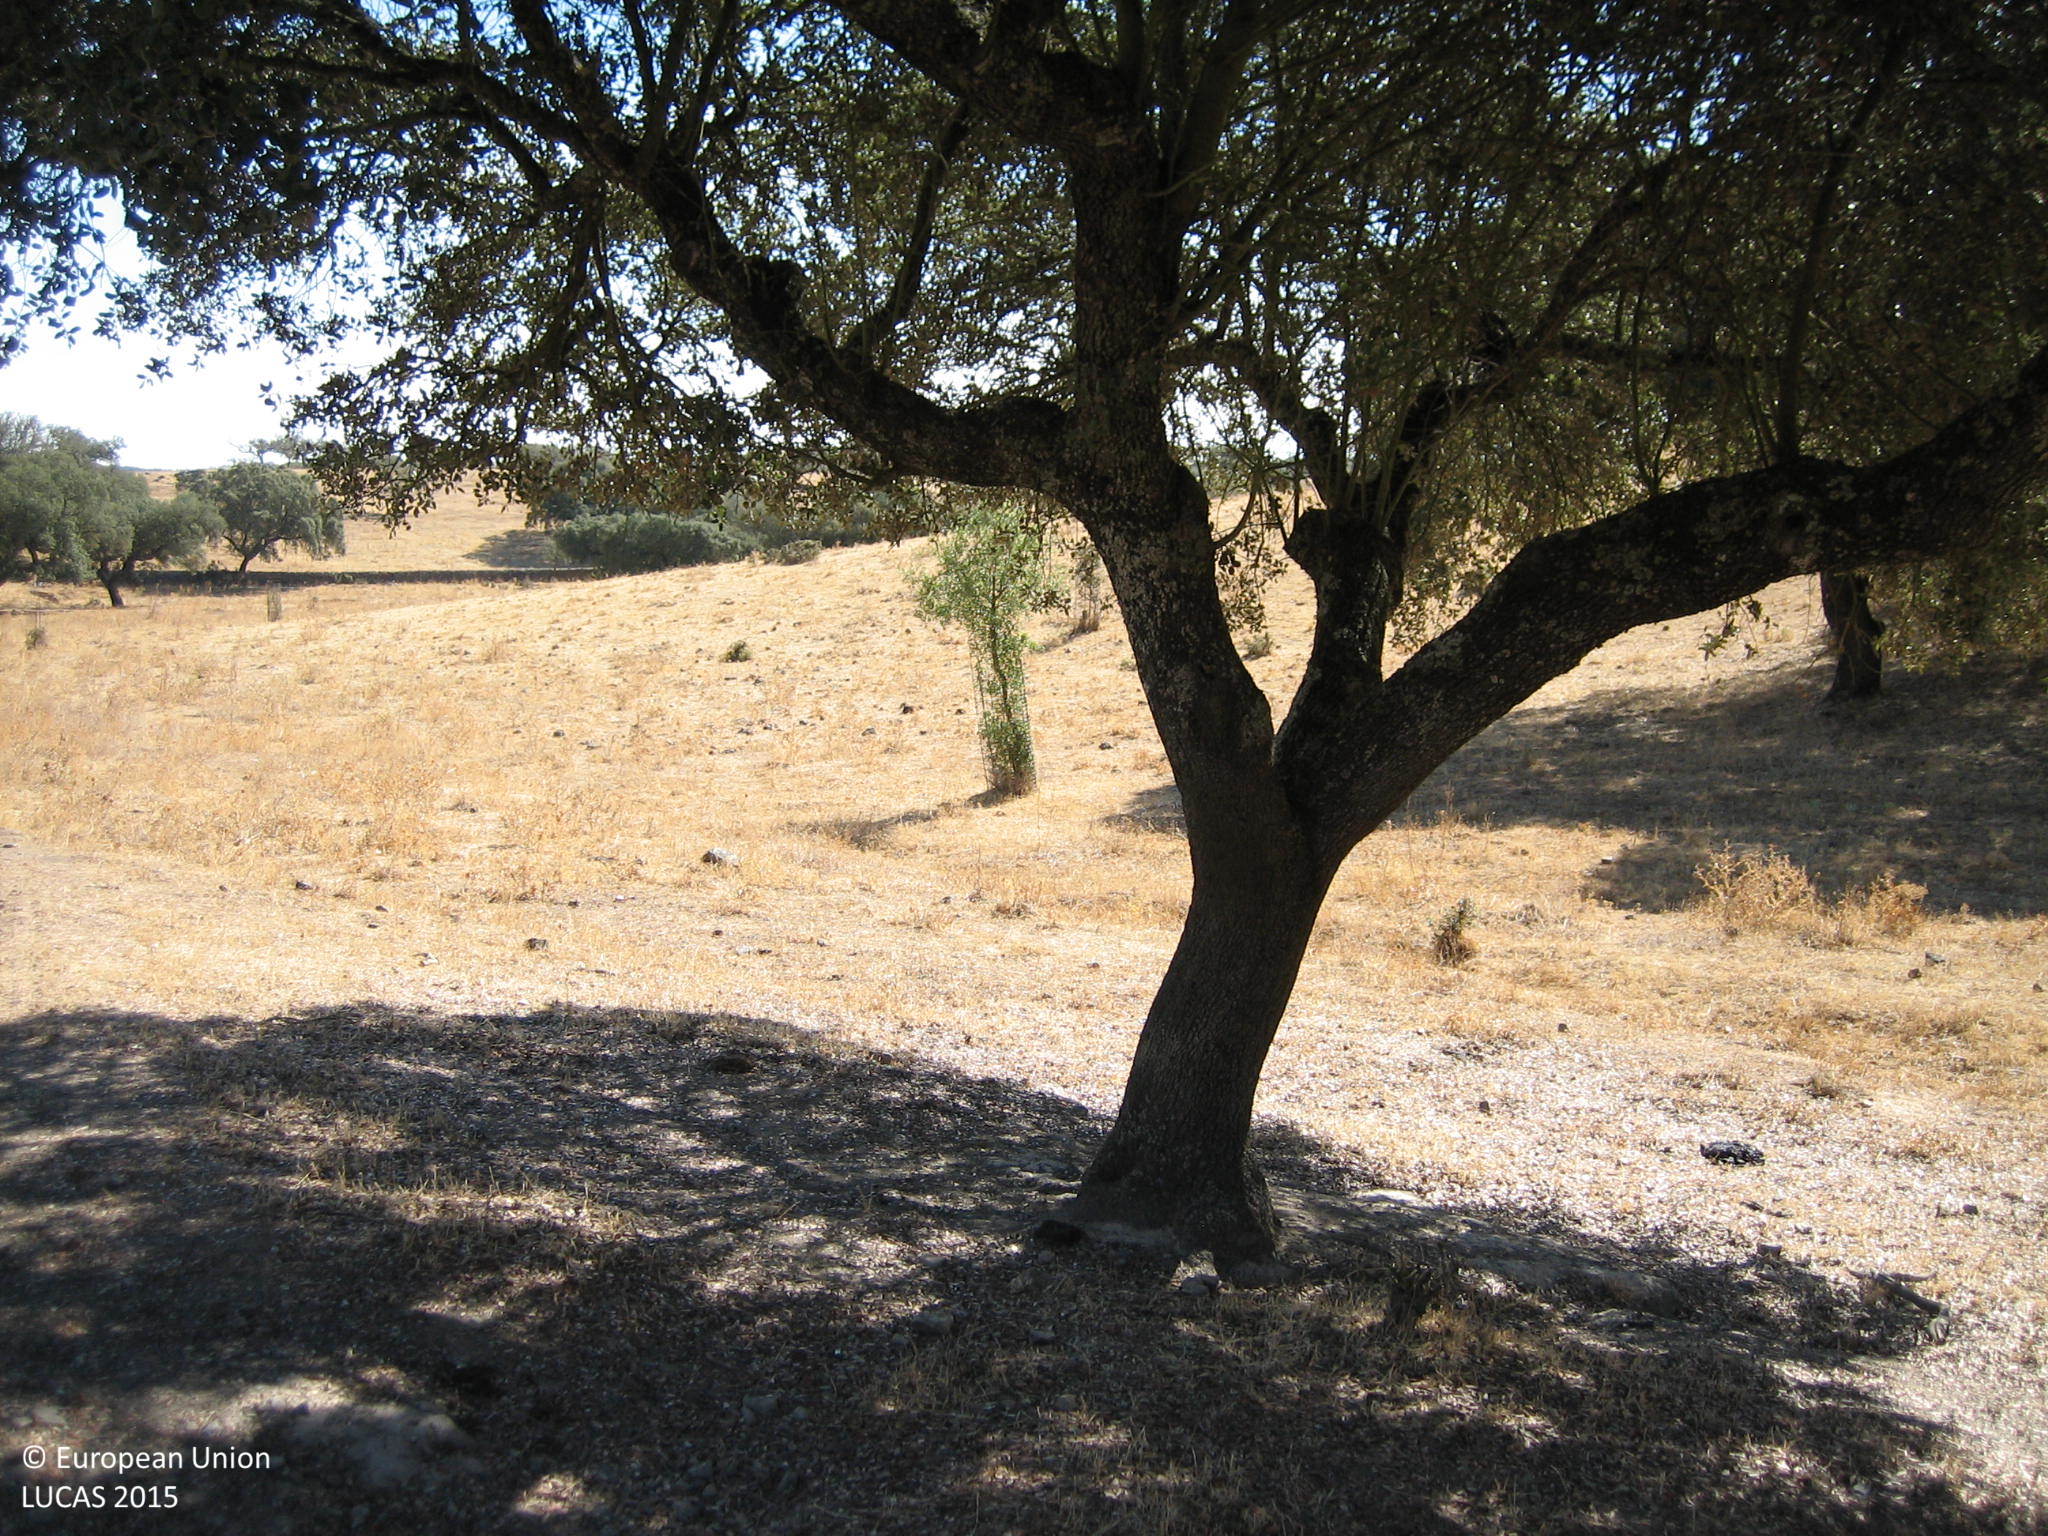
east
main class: Grassland
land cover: Grassland with sparse tree/shrub cover
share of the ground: > 75 %
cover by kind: herbaceous plants 95 %, broadleaved forest trees 5 %
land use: Forestry
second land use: Agriculture (excluding fallow land and kitchen gardens)
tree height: < 5 m
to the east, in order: Tracks; Broadleaved woodland; Grassland without tree/shrub cover; Broadleaved woodland; Dry stone walls
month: August
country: ES
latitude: 38.5332
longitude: -7.1954
